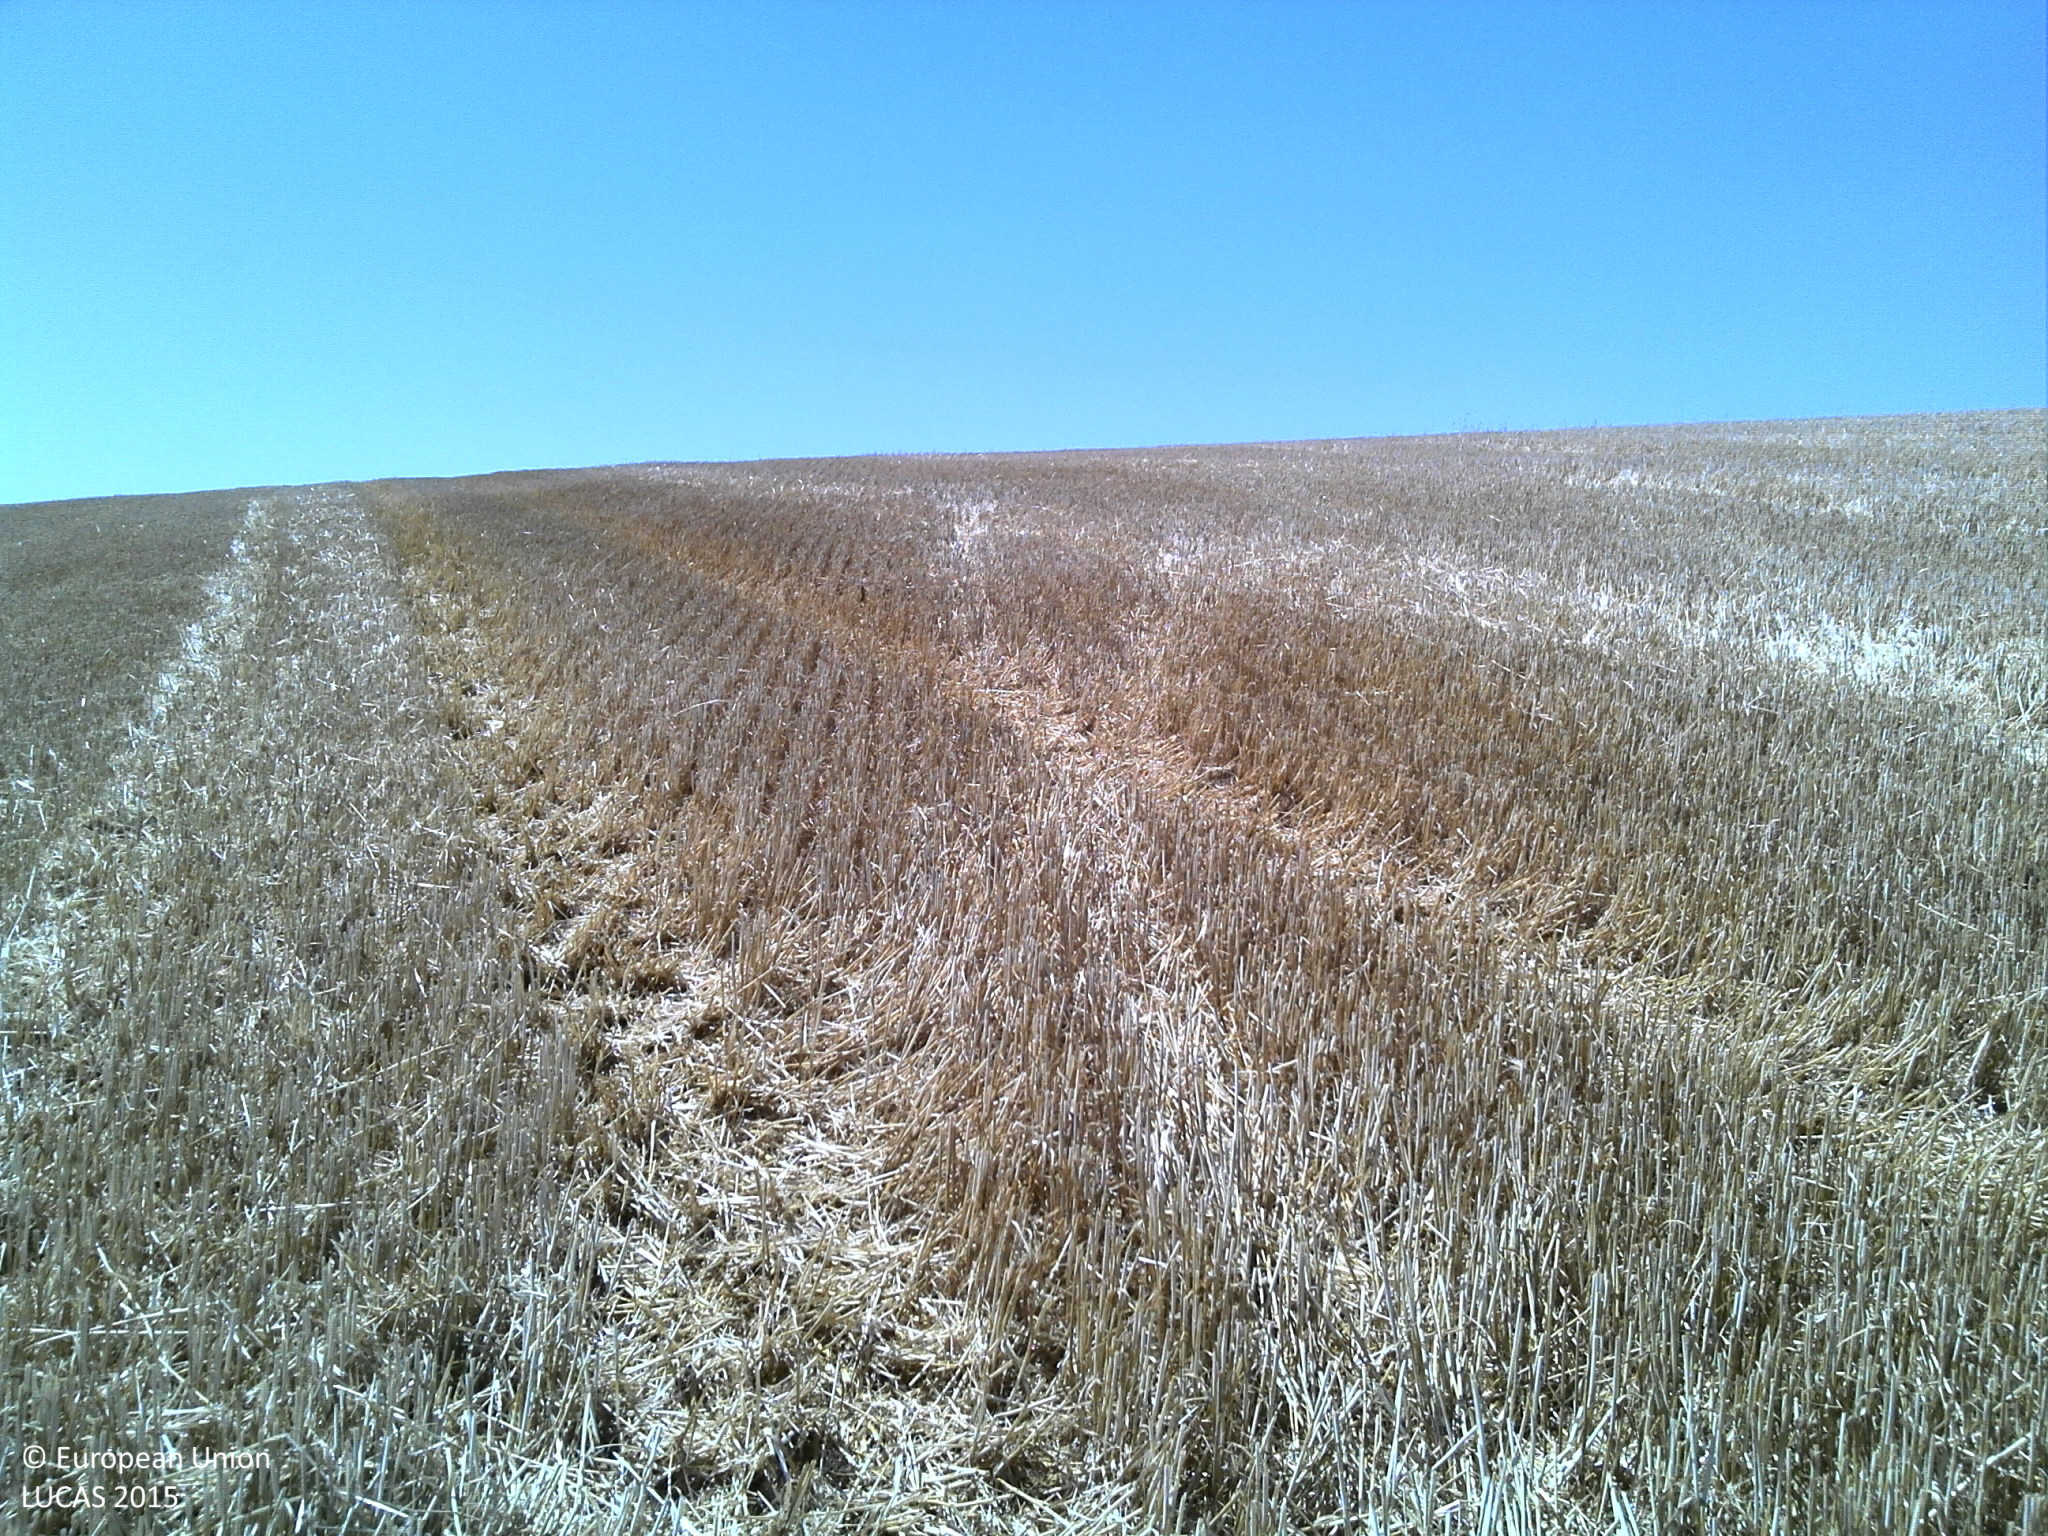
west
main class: Cropland
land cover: Common wheat
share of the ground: > 75 %
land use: Agriculture (excluding fallow land and kitchen gardens)
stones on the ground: < 10 %
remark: Harvested field
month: July
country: FR
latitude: 48.8724
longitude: 4.7210
